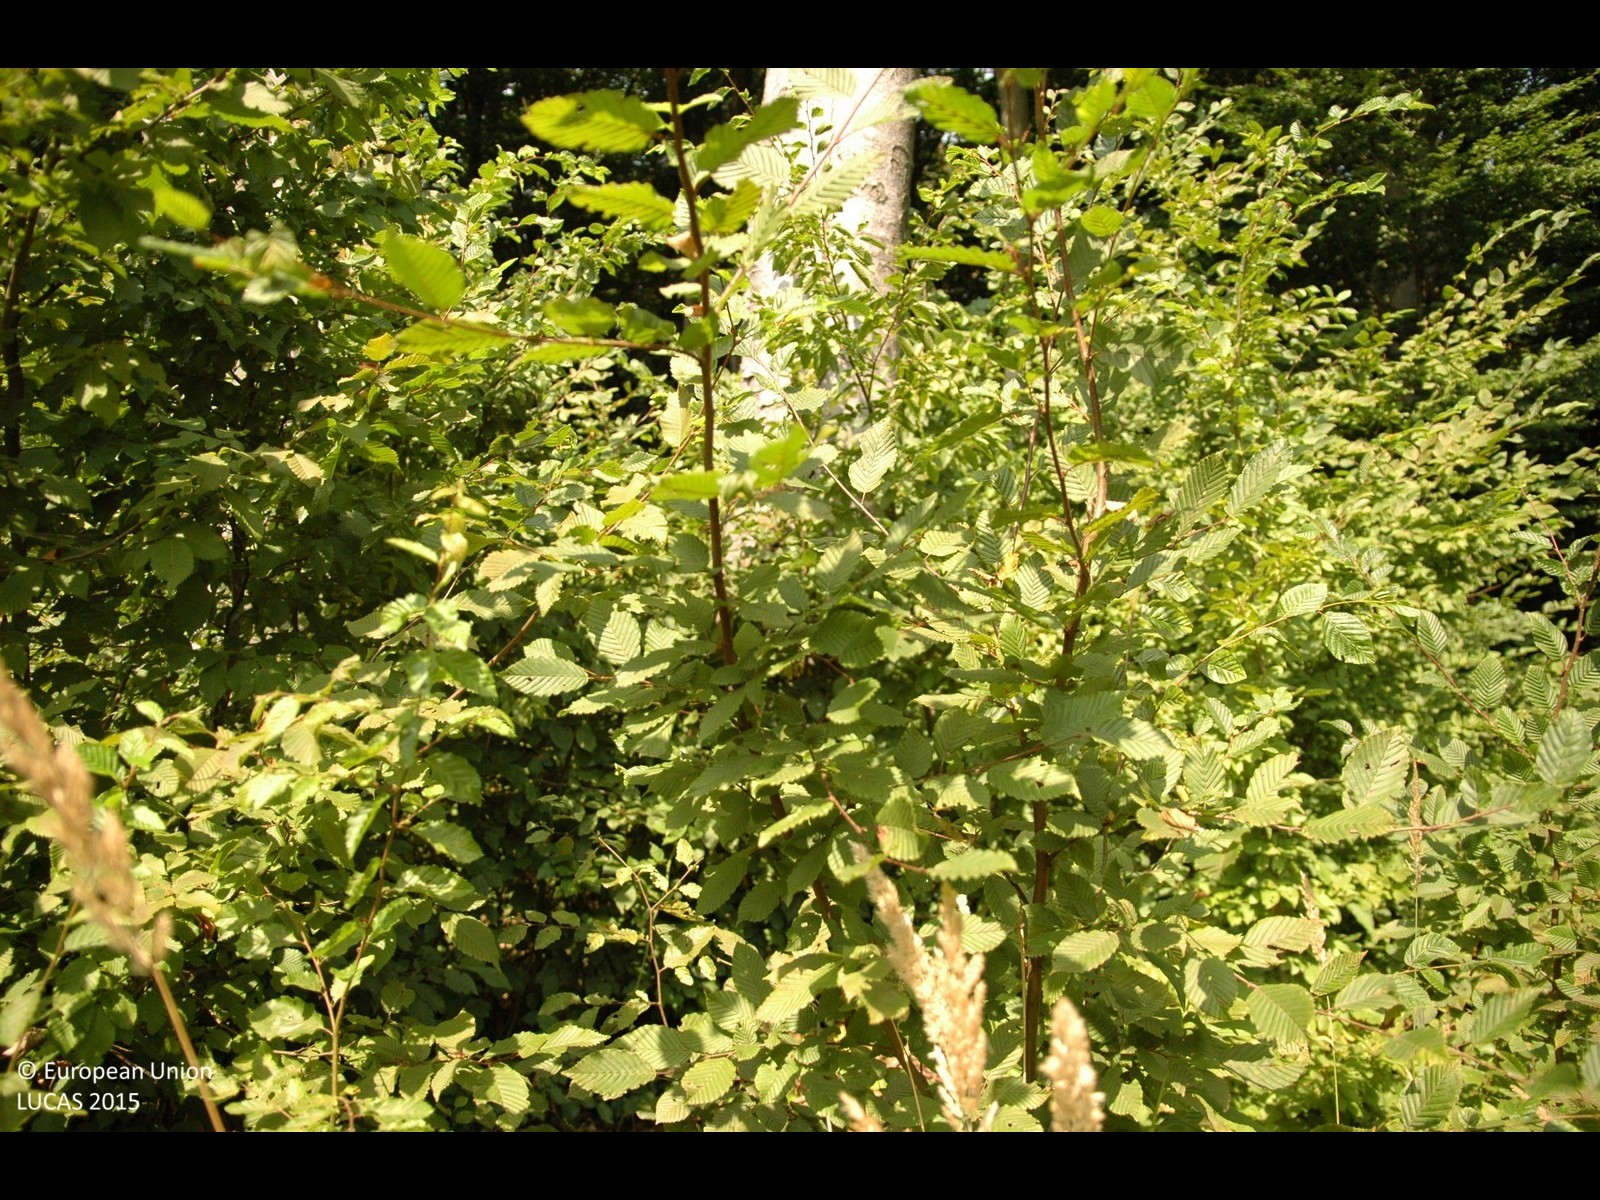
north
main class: Woodland
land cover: Broadleaved woodland
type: mesophytic deciduous forest
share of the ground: > 75 %
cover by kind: broadleaved forest trees 100 %
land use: Forestry
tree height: < 5 m
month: July
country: HR
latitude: 46.1642
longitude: 16.6184
